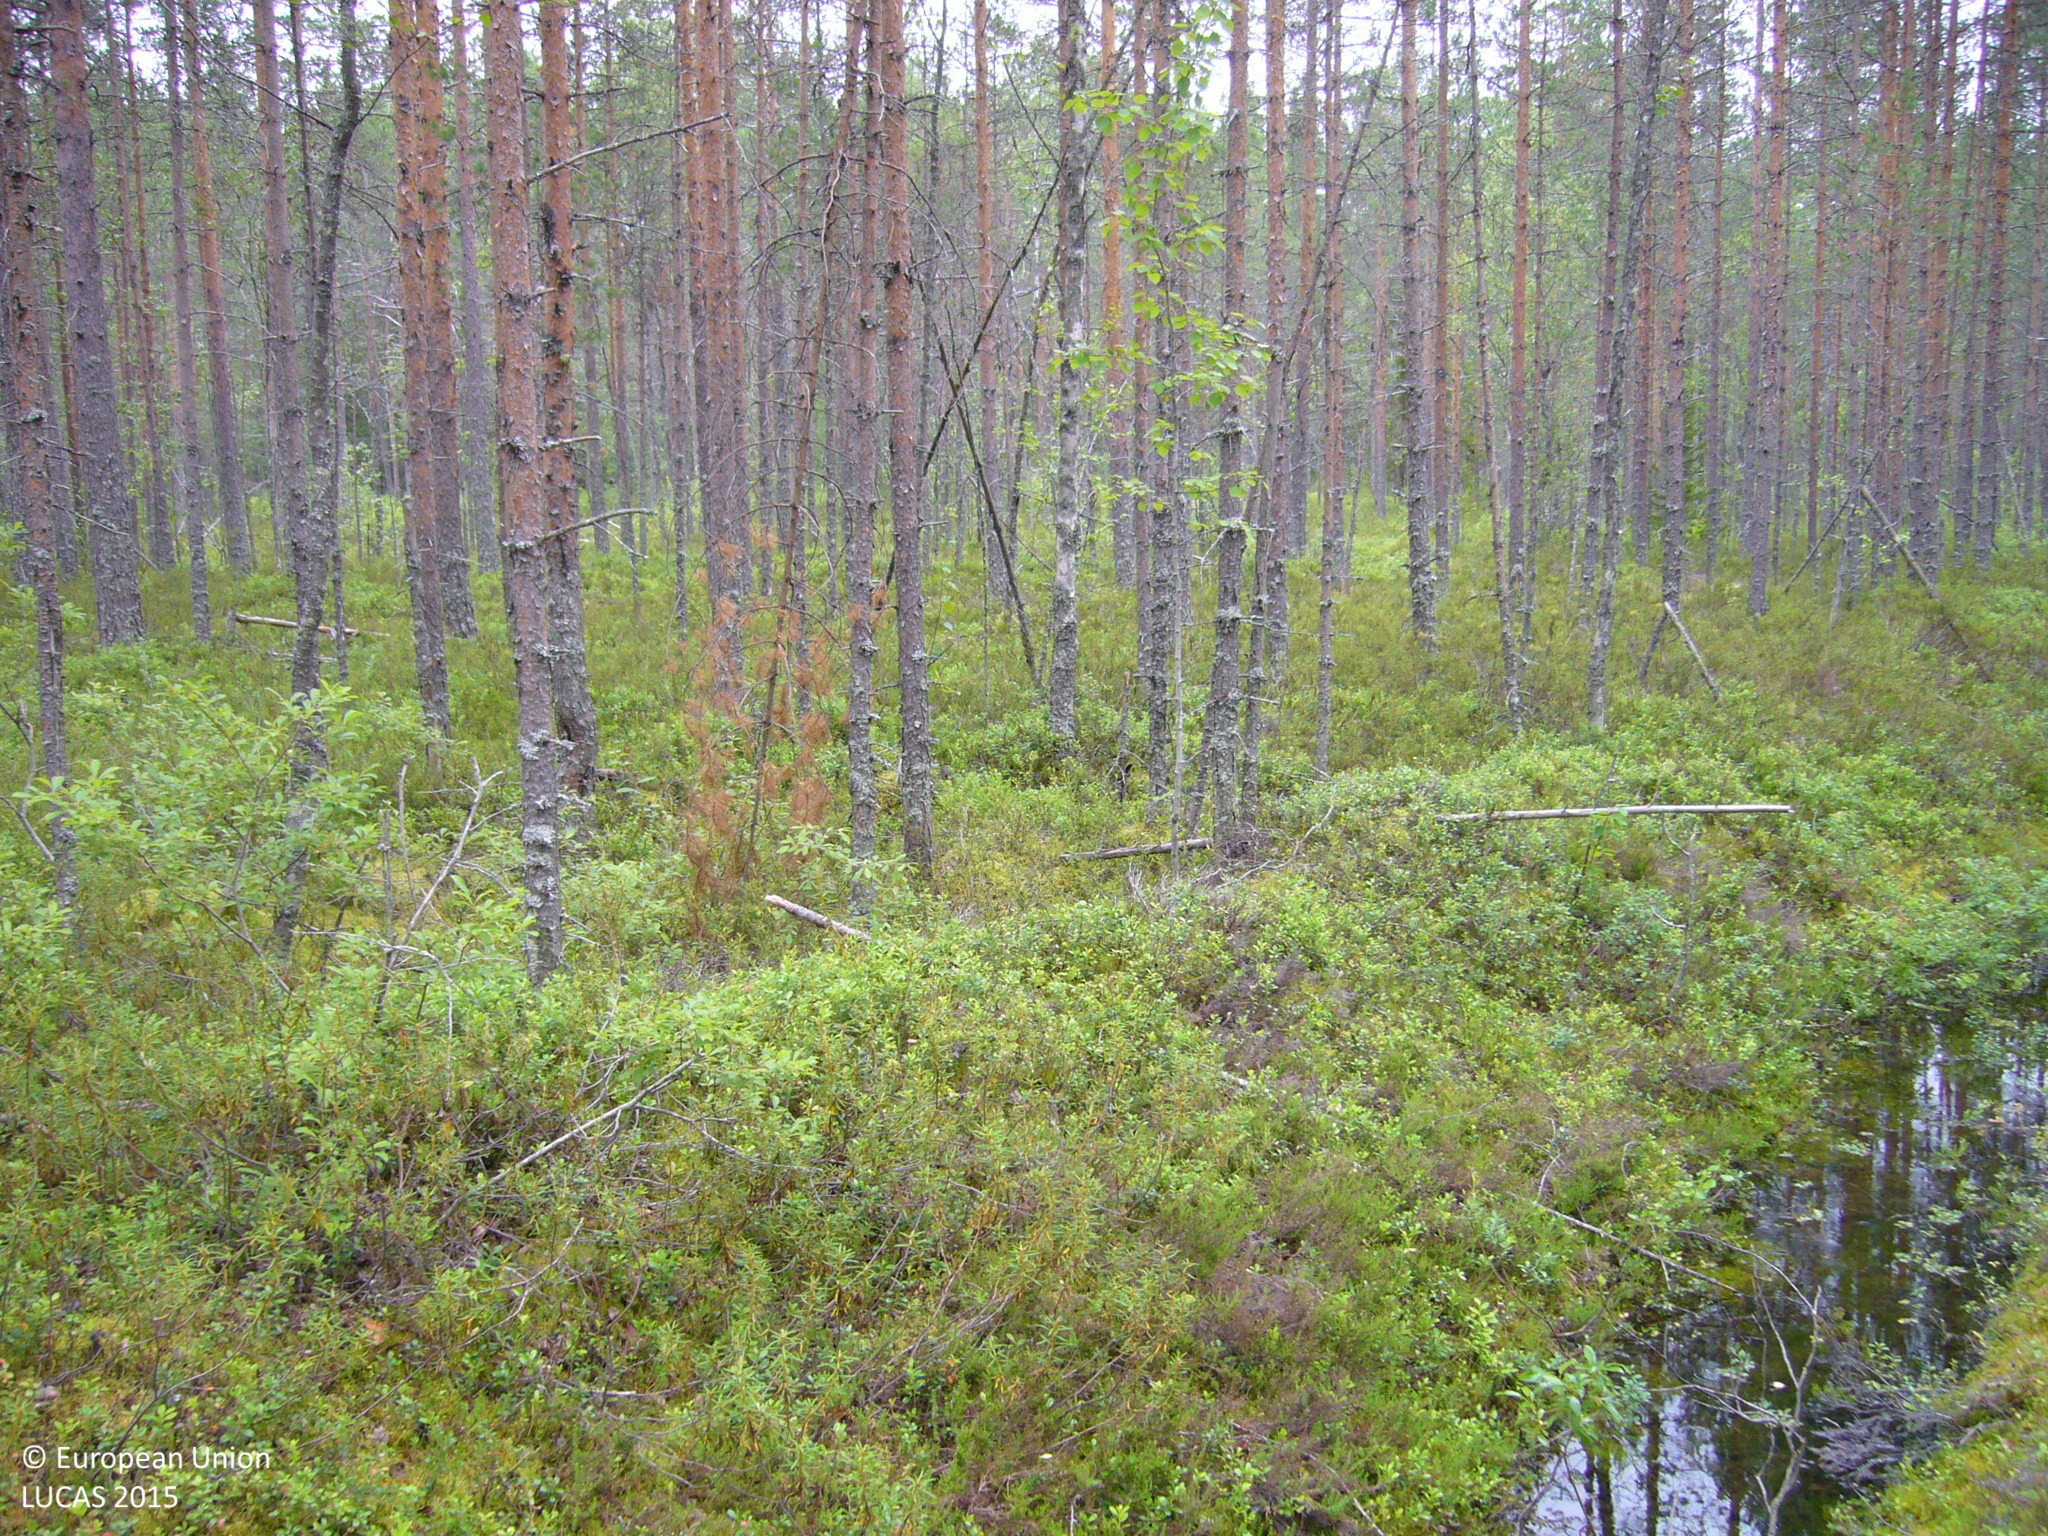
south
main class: Woodland
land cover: Pine dominated coniferous woodland
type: boreal forest
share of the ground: 50 - 75 %
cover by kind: coniferous forest trees 55 %, shrubs 40 %, broadleaved forest trees 5 %
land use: Forestry
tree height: > 5 m
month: July
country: FI
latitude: 63.9672
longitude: 26.3526
